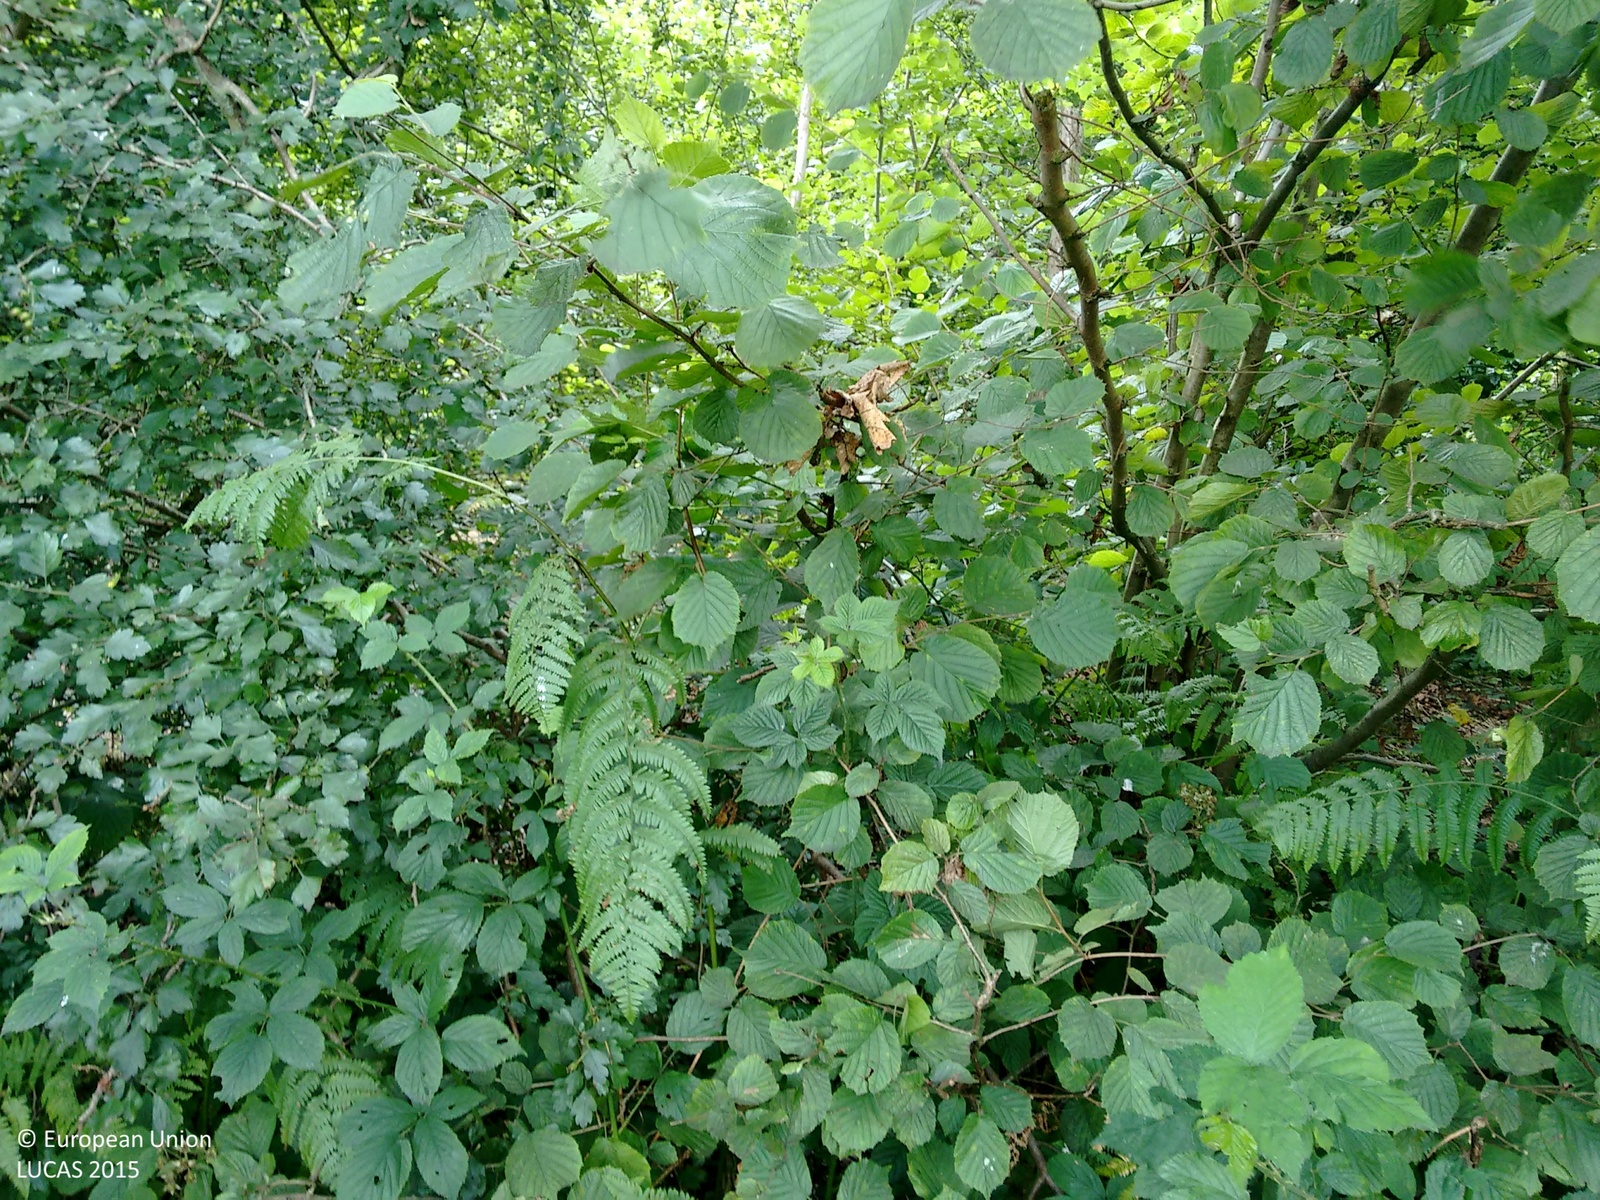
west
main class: Woodland
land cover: Broadleaved woodland
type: mesophytic deciduous forest
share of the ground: > 75 %
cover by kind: broadleaved forest trees 75 %, shrubs 25 %
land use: Forestry
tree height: > 5 m
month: August
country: GB
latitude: 51.2741
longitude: -0.1112
